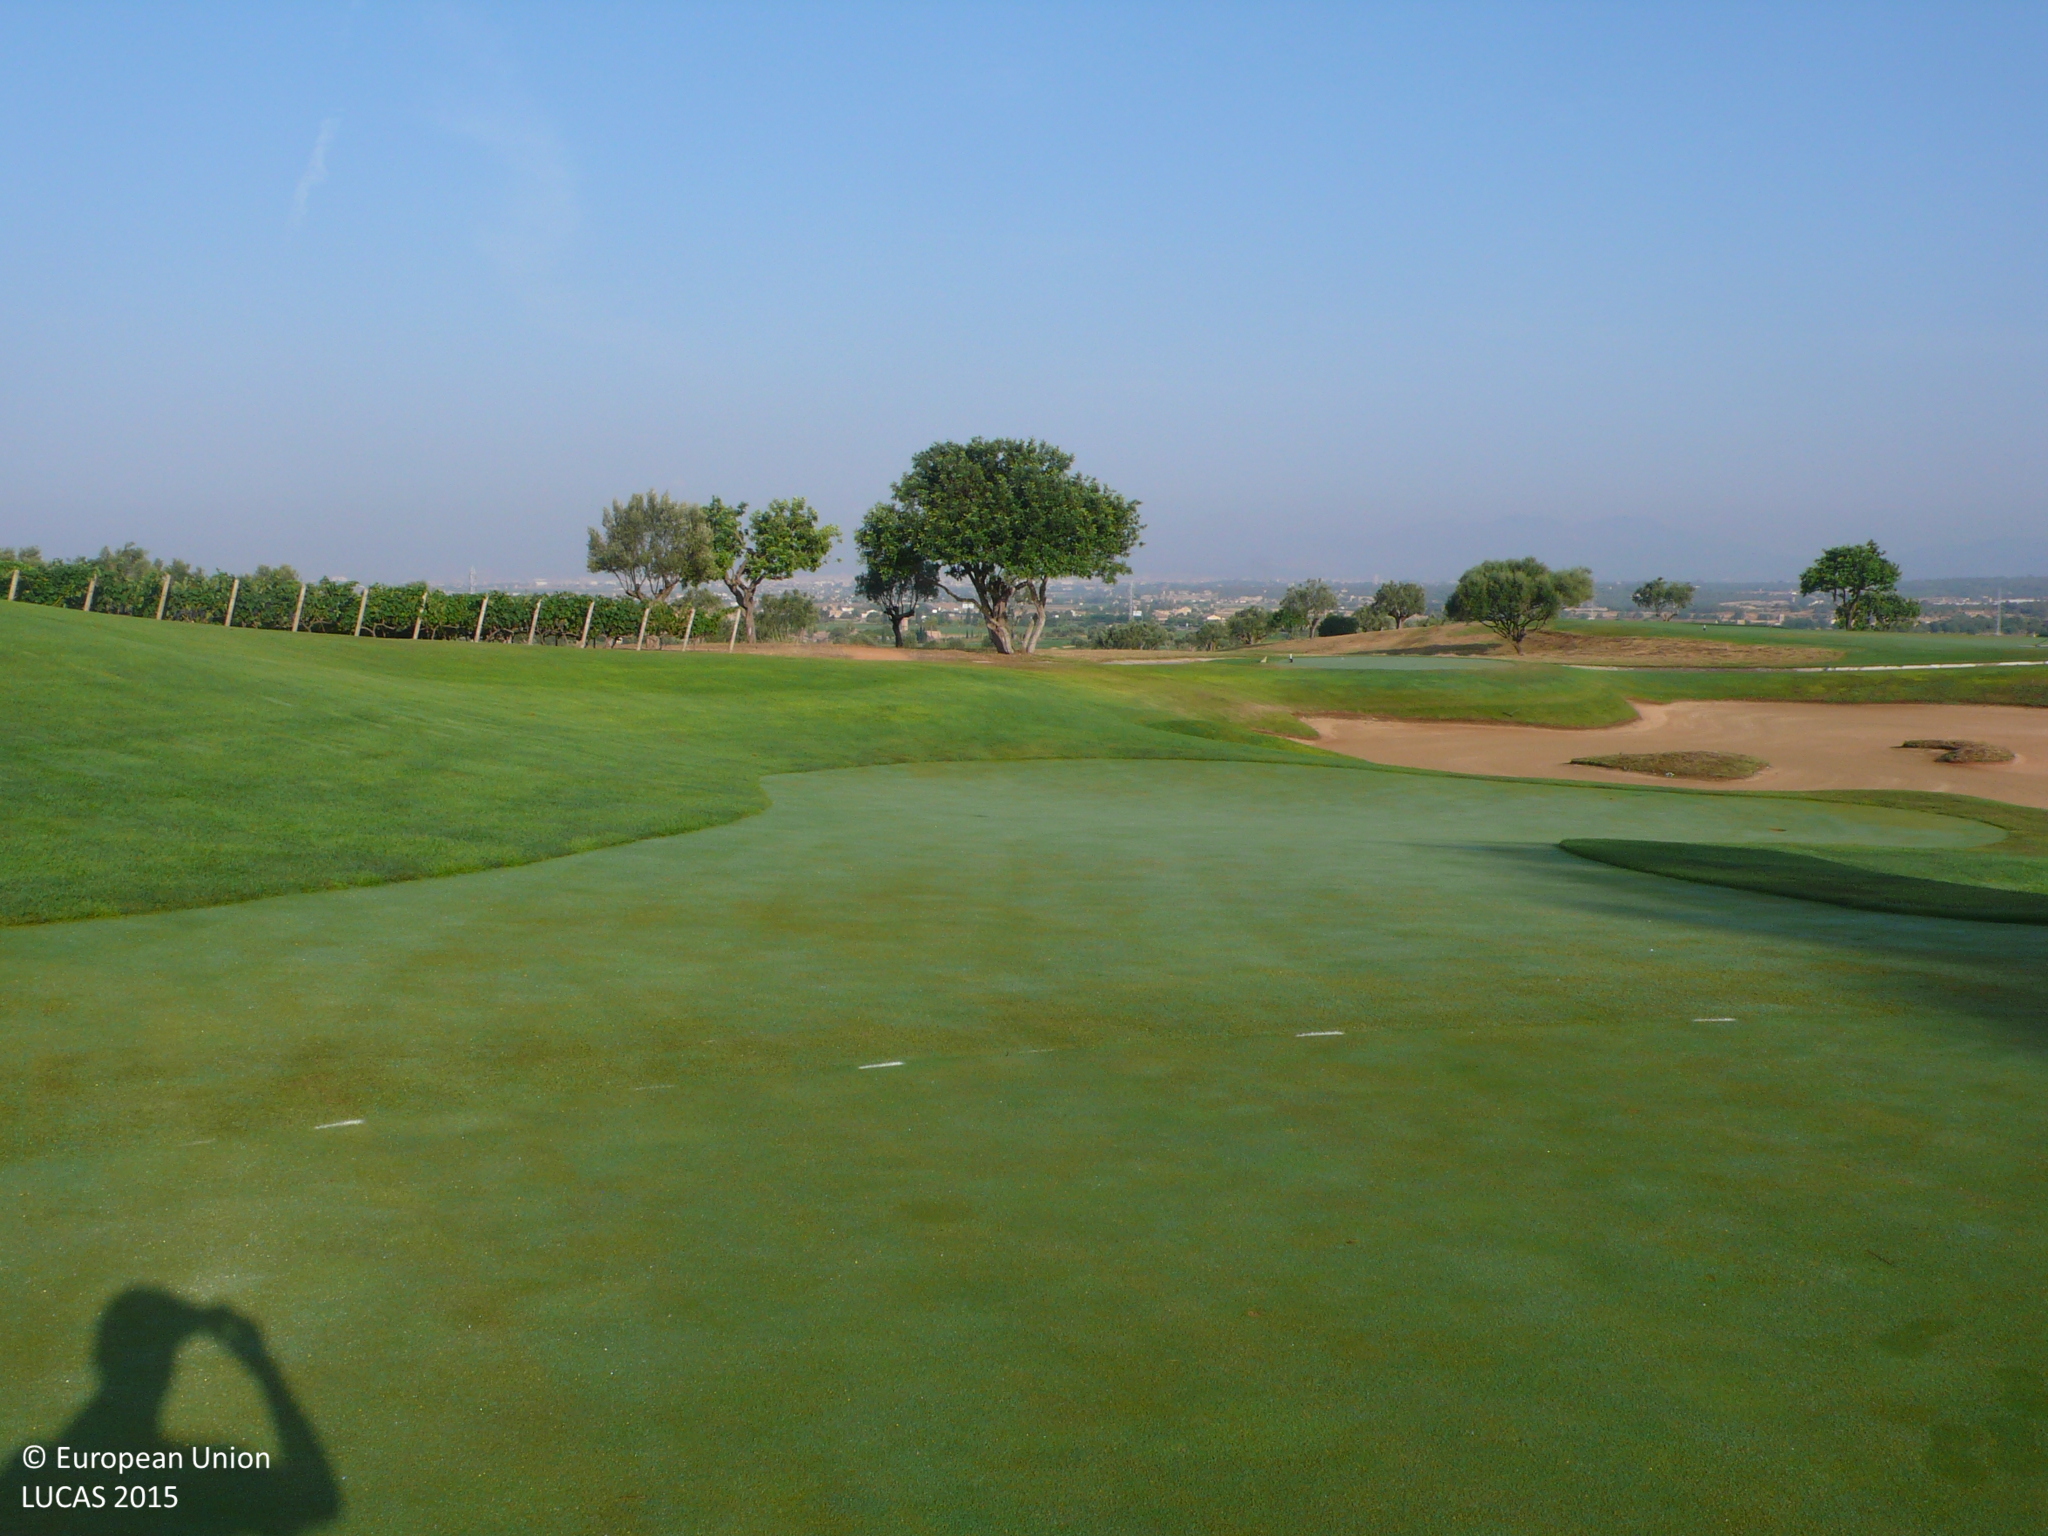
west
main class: Grassland
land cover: Grassland without tree/shrub cover
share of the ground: > 75 %
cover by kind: herbaceous plants 90 %, unconsolidated bare surface 10 %
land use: Sport
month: July
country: ES
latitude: 39.5666
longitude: 2.8020
